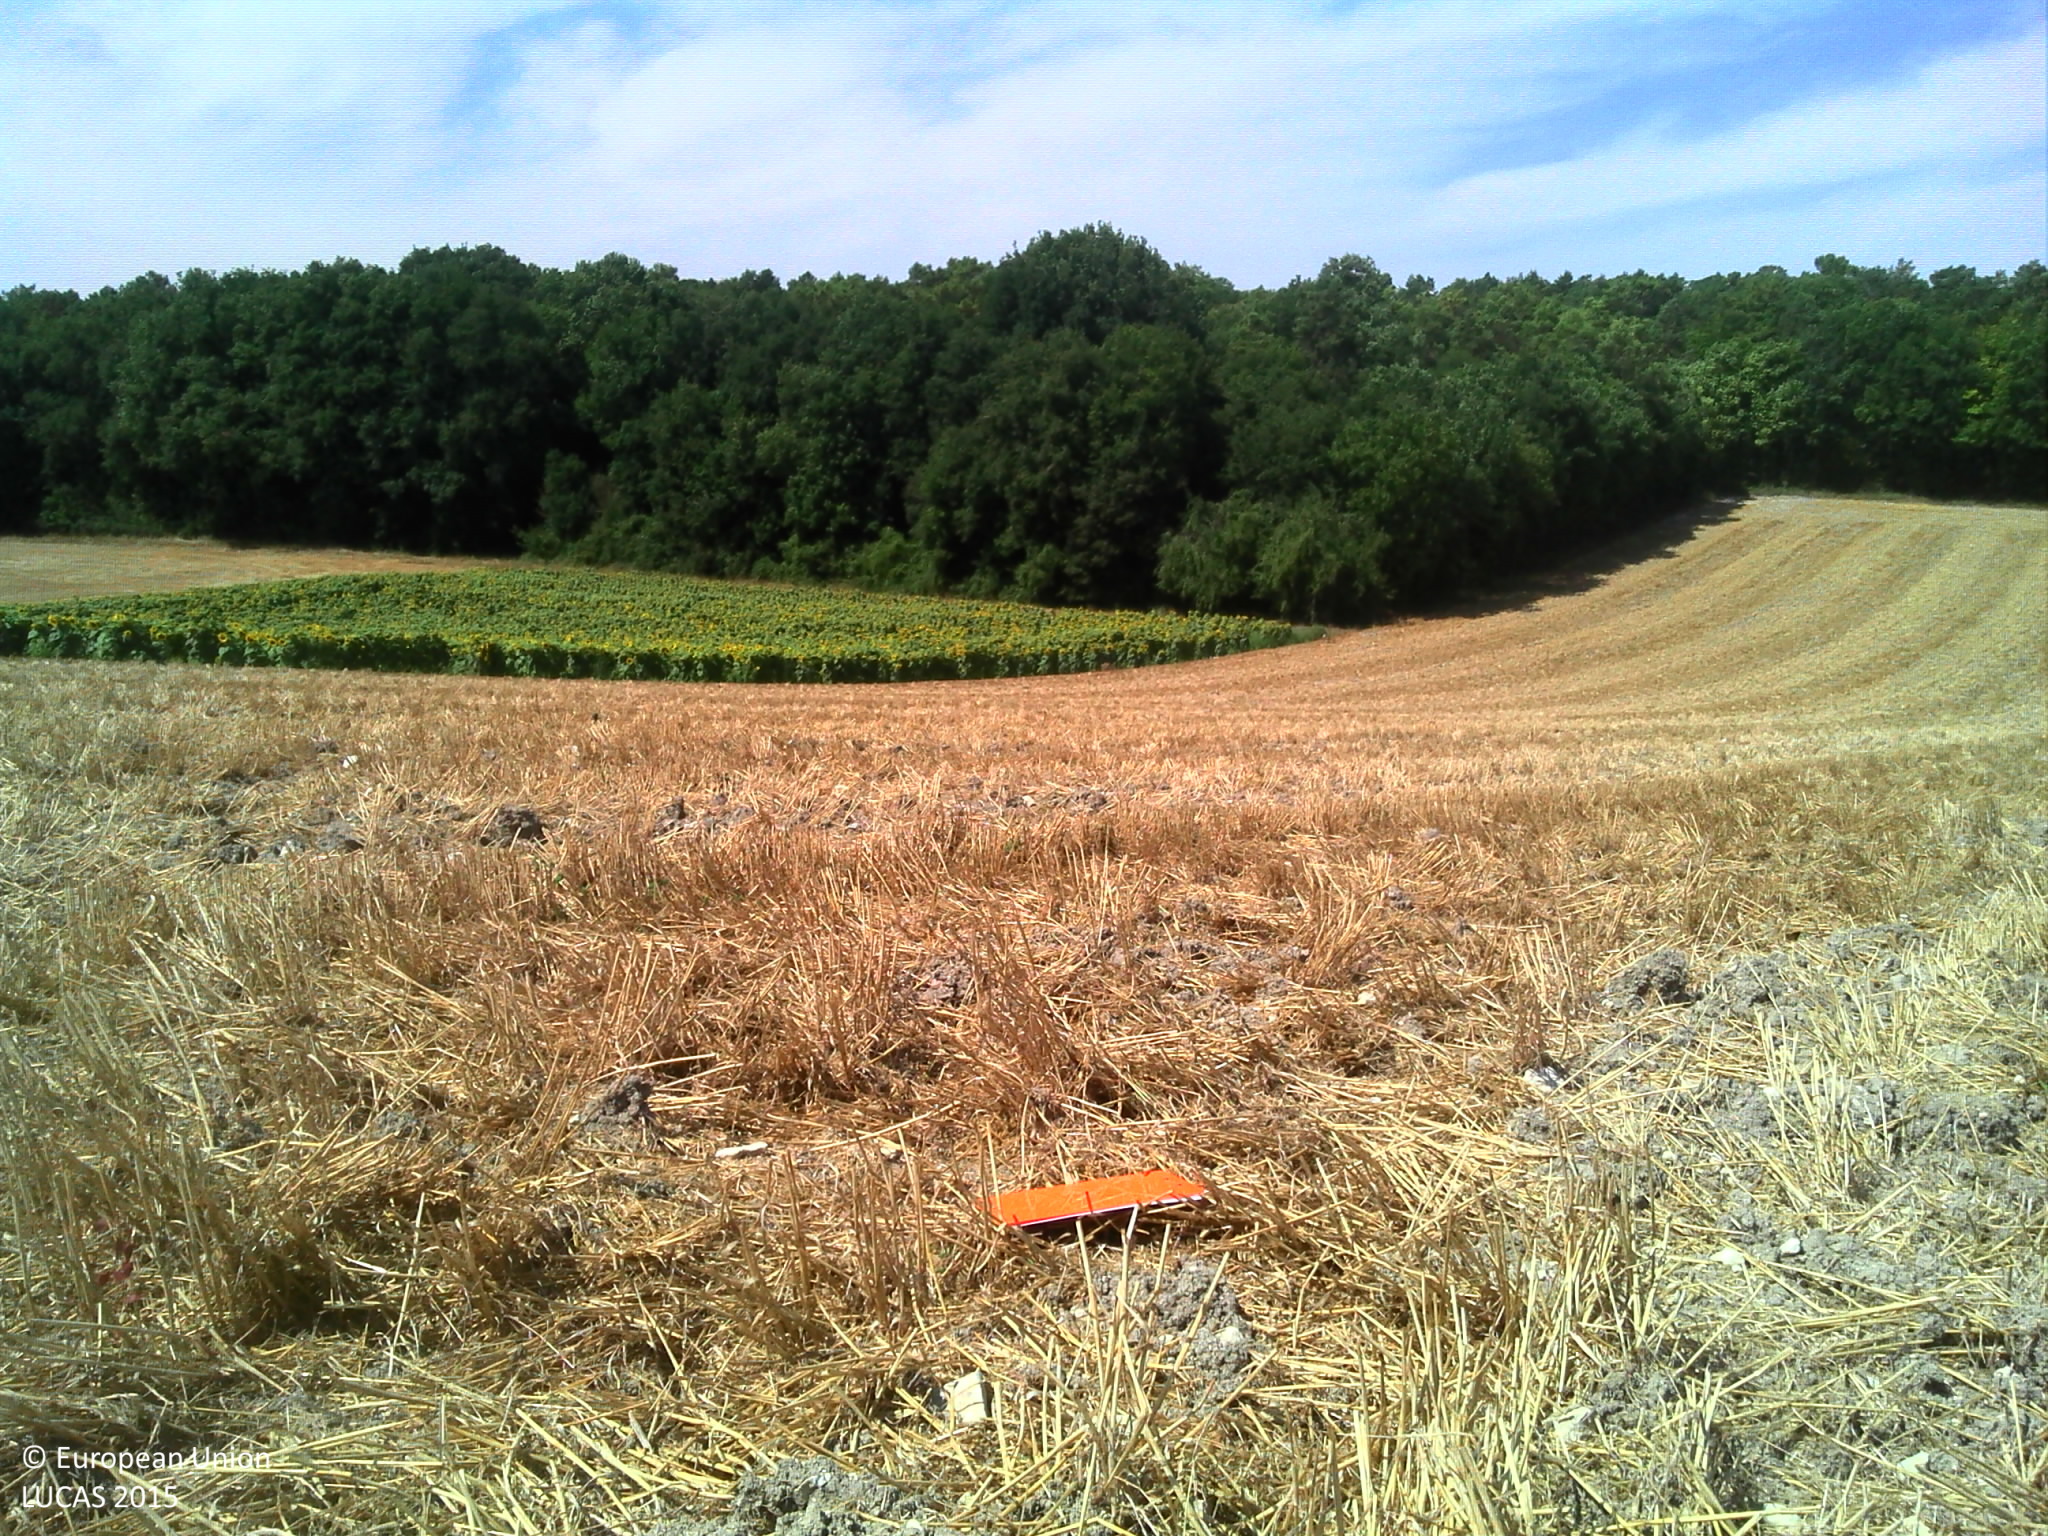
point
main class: Cropland
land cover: Common wheat
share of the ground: > 75 %
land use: Agriculture (excluding fallow land and kitchen gardens)
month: July
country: FR
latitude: 47.0792
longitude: 0.4044
